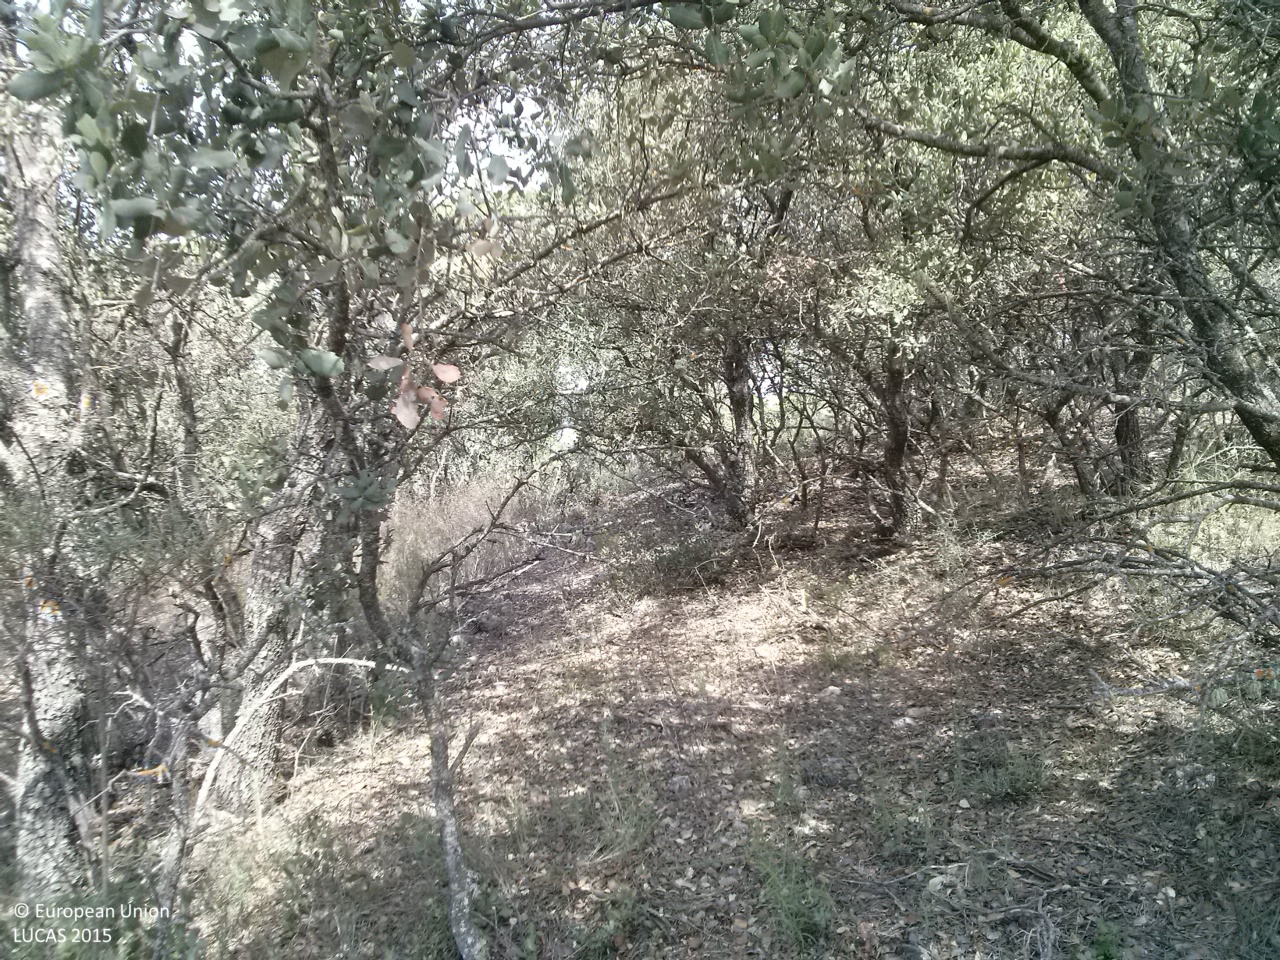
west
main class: Woodland
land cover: Other mixed woodland
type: broadleaved evergreen forest
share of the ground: 50 - 75 %
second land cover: Shrubland without tree cover
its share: 10 - 25 %
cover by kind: broadleaved forest trees 45 %, coniferous forest trees 25 %, shrubs 20 %, herbaceous plants 10 %
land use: Forestry
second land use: Agriculture (excluding fallow land and kitchen gardens)
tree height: > 5 m
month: June
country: ES
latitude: 39.9668
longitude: -1.8485
